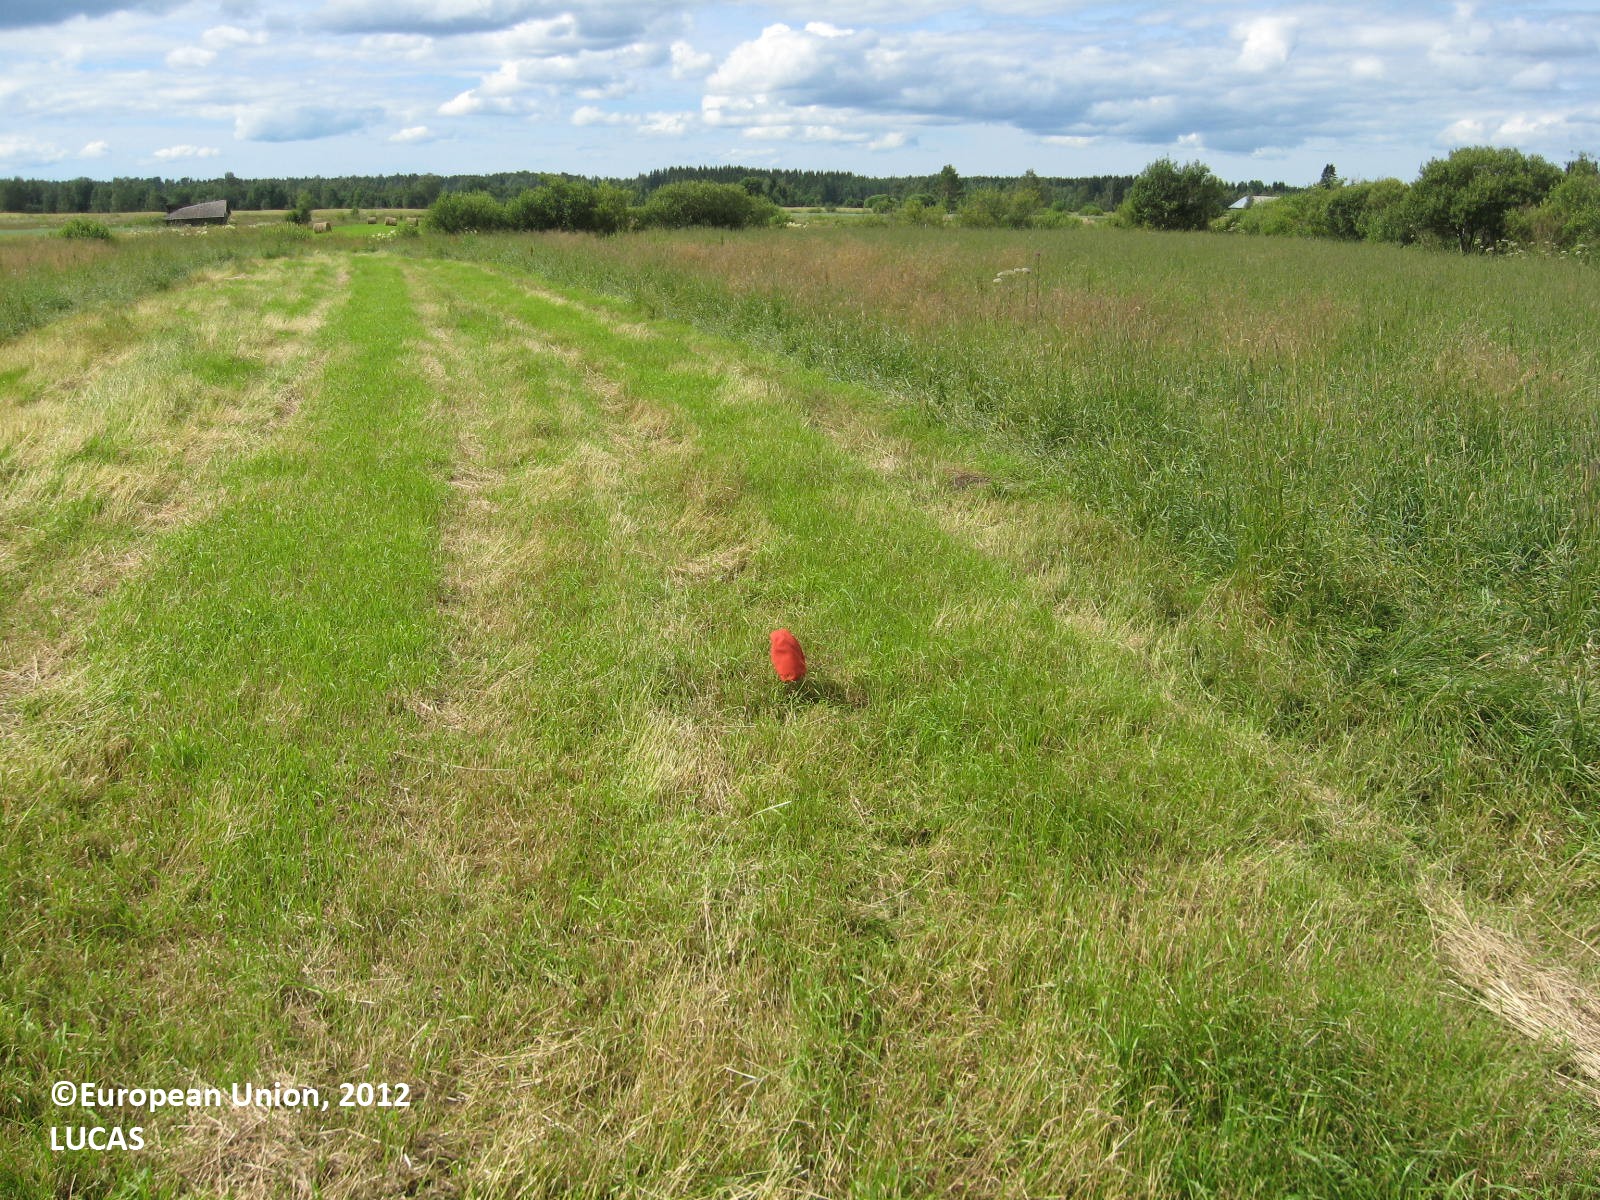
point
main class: Cropland
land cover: Temporary grasslands
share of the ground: > 75 %
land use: Agriculture (excluding fallow land and kitchen gardens)
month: July
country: FI
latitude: 62.0528
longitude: 22.2783
